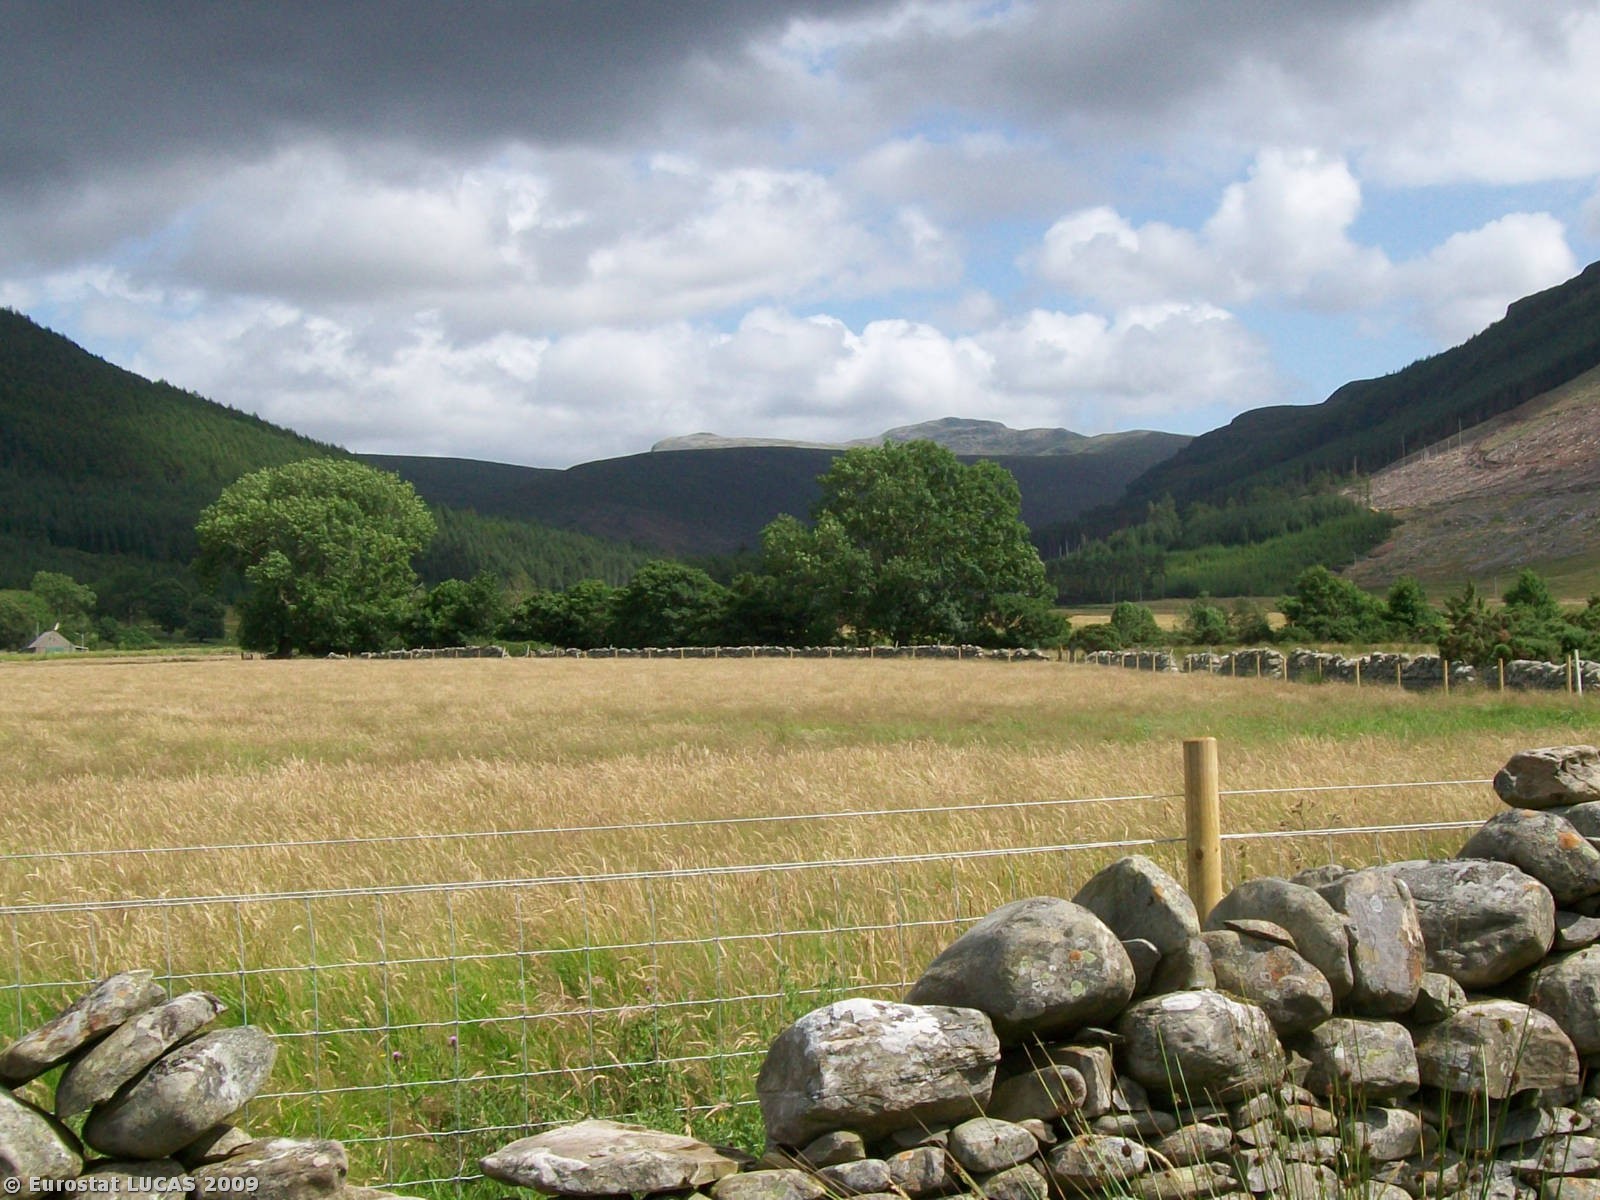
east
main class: Grassland
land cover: Grassland without tree/shrub cover
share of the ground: > 75 %
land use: Agriculture (excluding fallow land and kitchen gardens)
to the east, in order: Grassland without tree/shrub cover; Dry stone walls; Fences; Grassland without tree/shrub cover; Fences; Dry stone walls; Grassland without tree/shrub cover; Lines of trees; Inland running water; Shrubland without tree cover; Grassland without tree/shrub cover
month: July
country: GB
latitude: 57.8214
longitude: -5.0692
